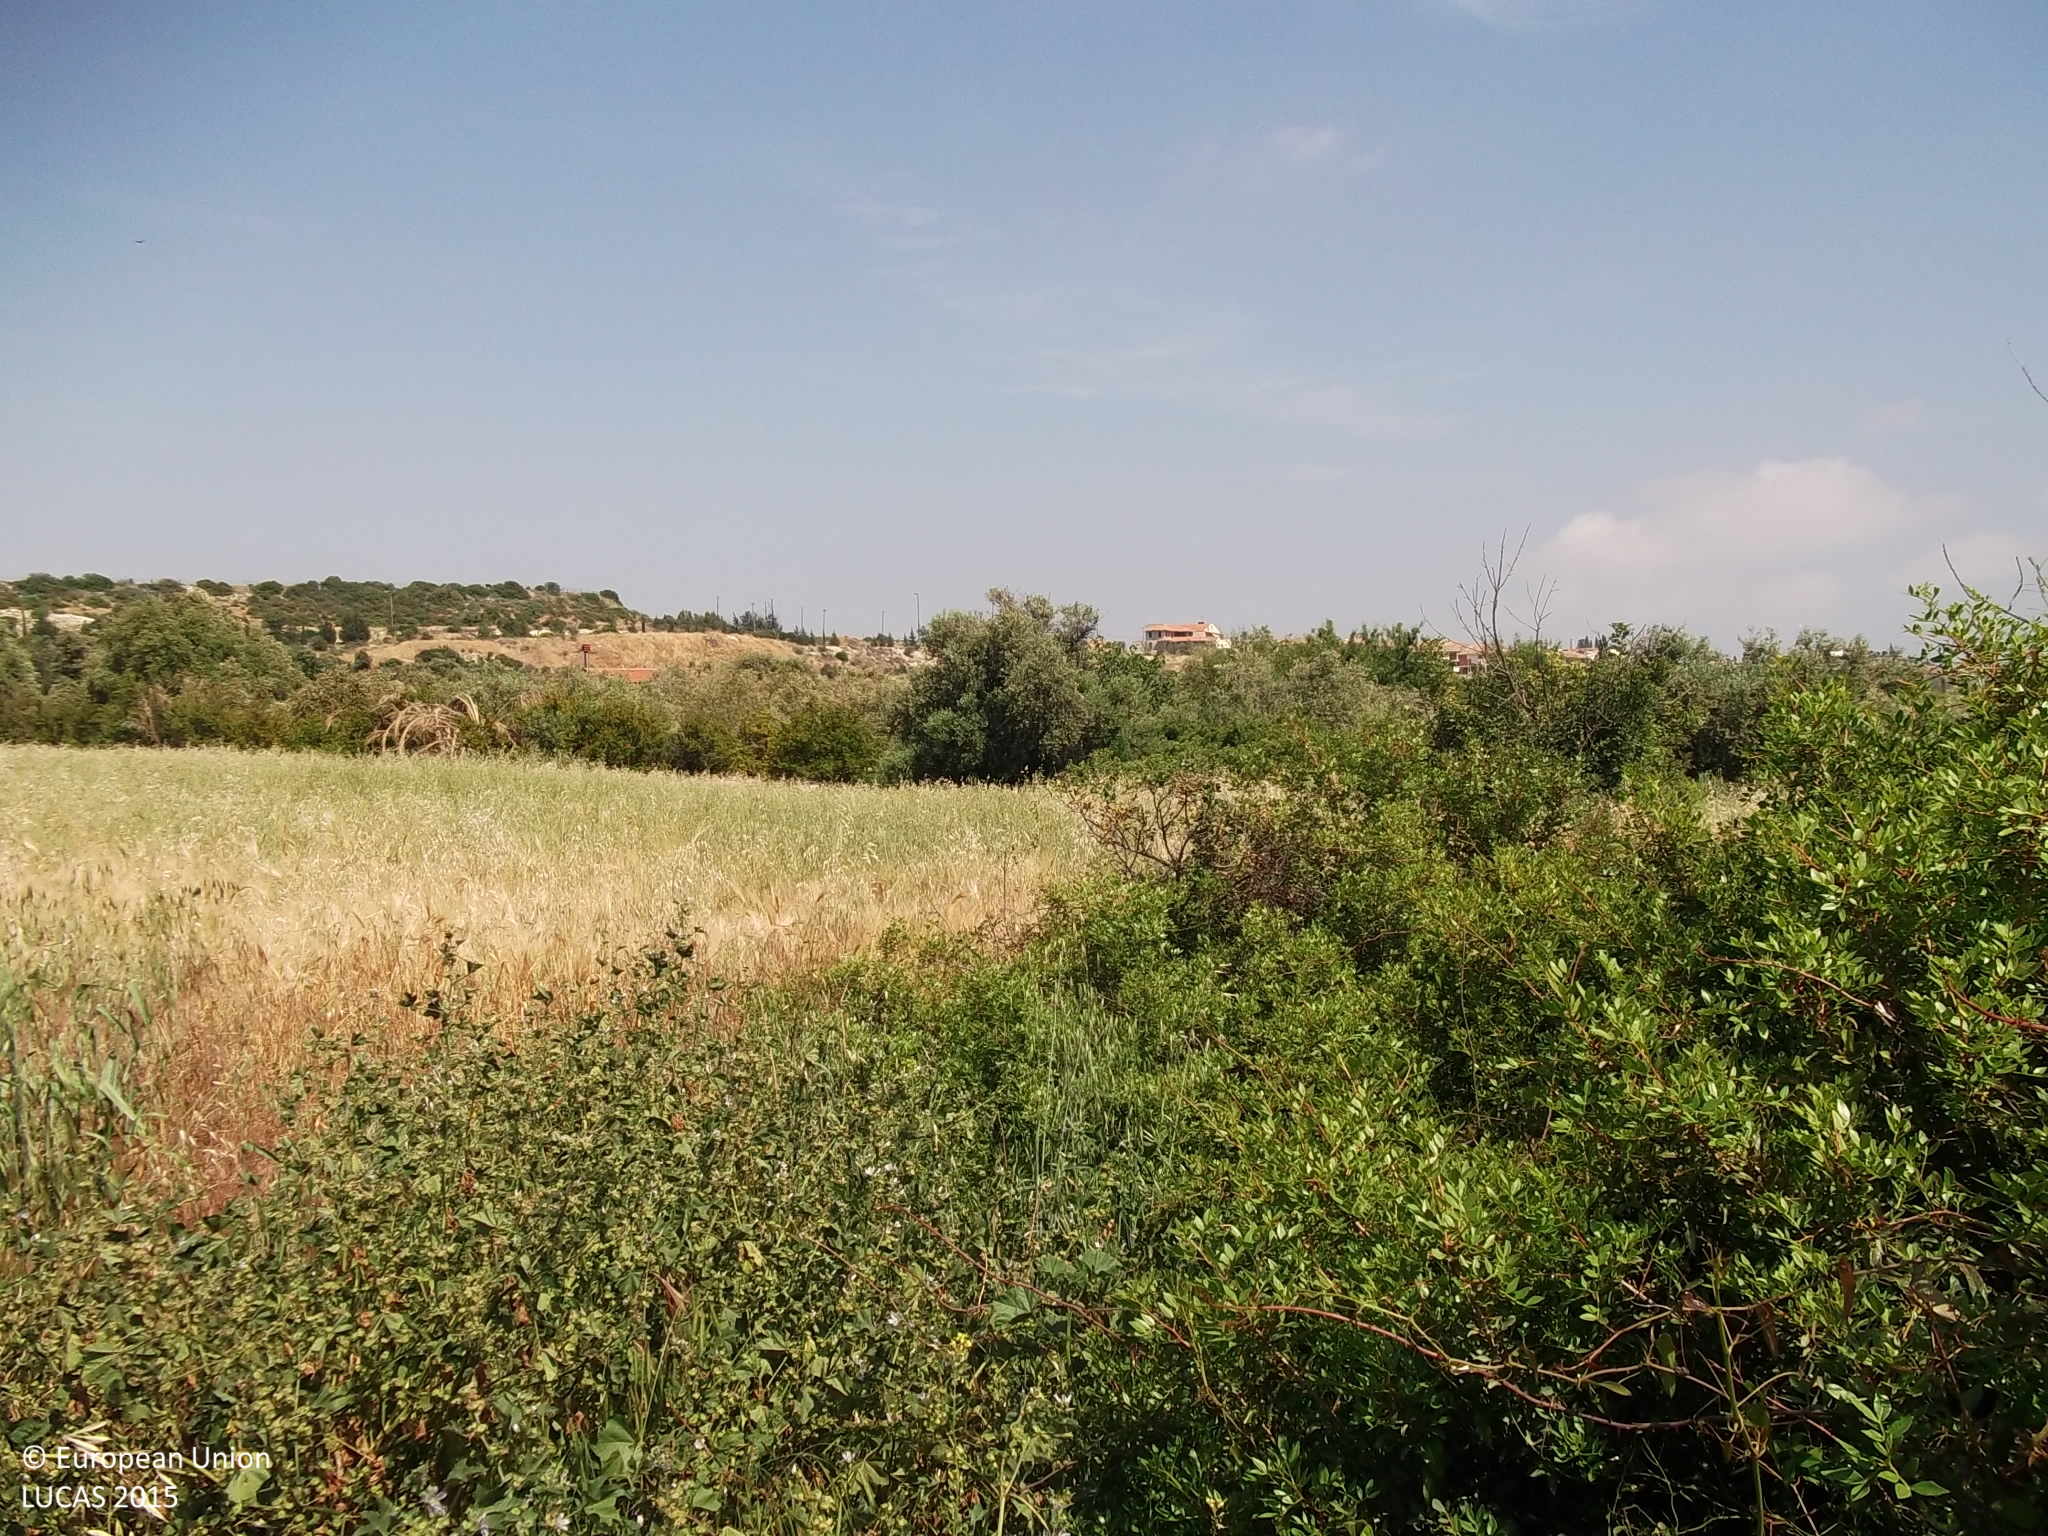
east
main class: Cropland
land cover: Mixed cereals for fodder
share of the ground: > 75 %
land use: Agriculture (excluding fallow land and kitchen gardens)
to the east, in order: Mixed cereals for fodder; Shrubland with sparse tree cover; Mixed cereals for fodder; Abandoned hedges; Olive groves; Abandoned hedges; Olive groves; Artificial constructions in urban areas; Olive groves; Tracks; Mixed cereals for fodder
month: May
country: CY
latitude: 34.8052
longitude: 33.3207
